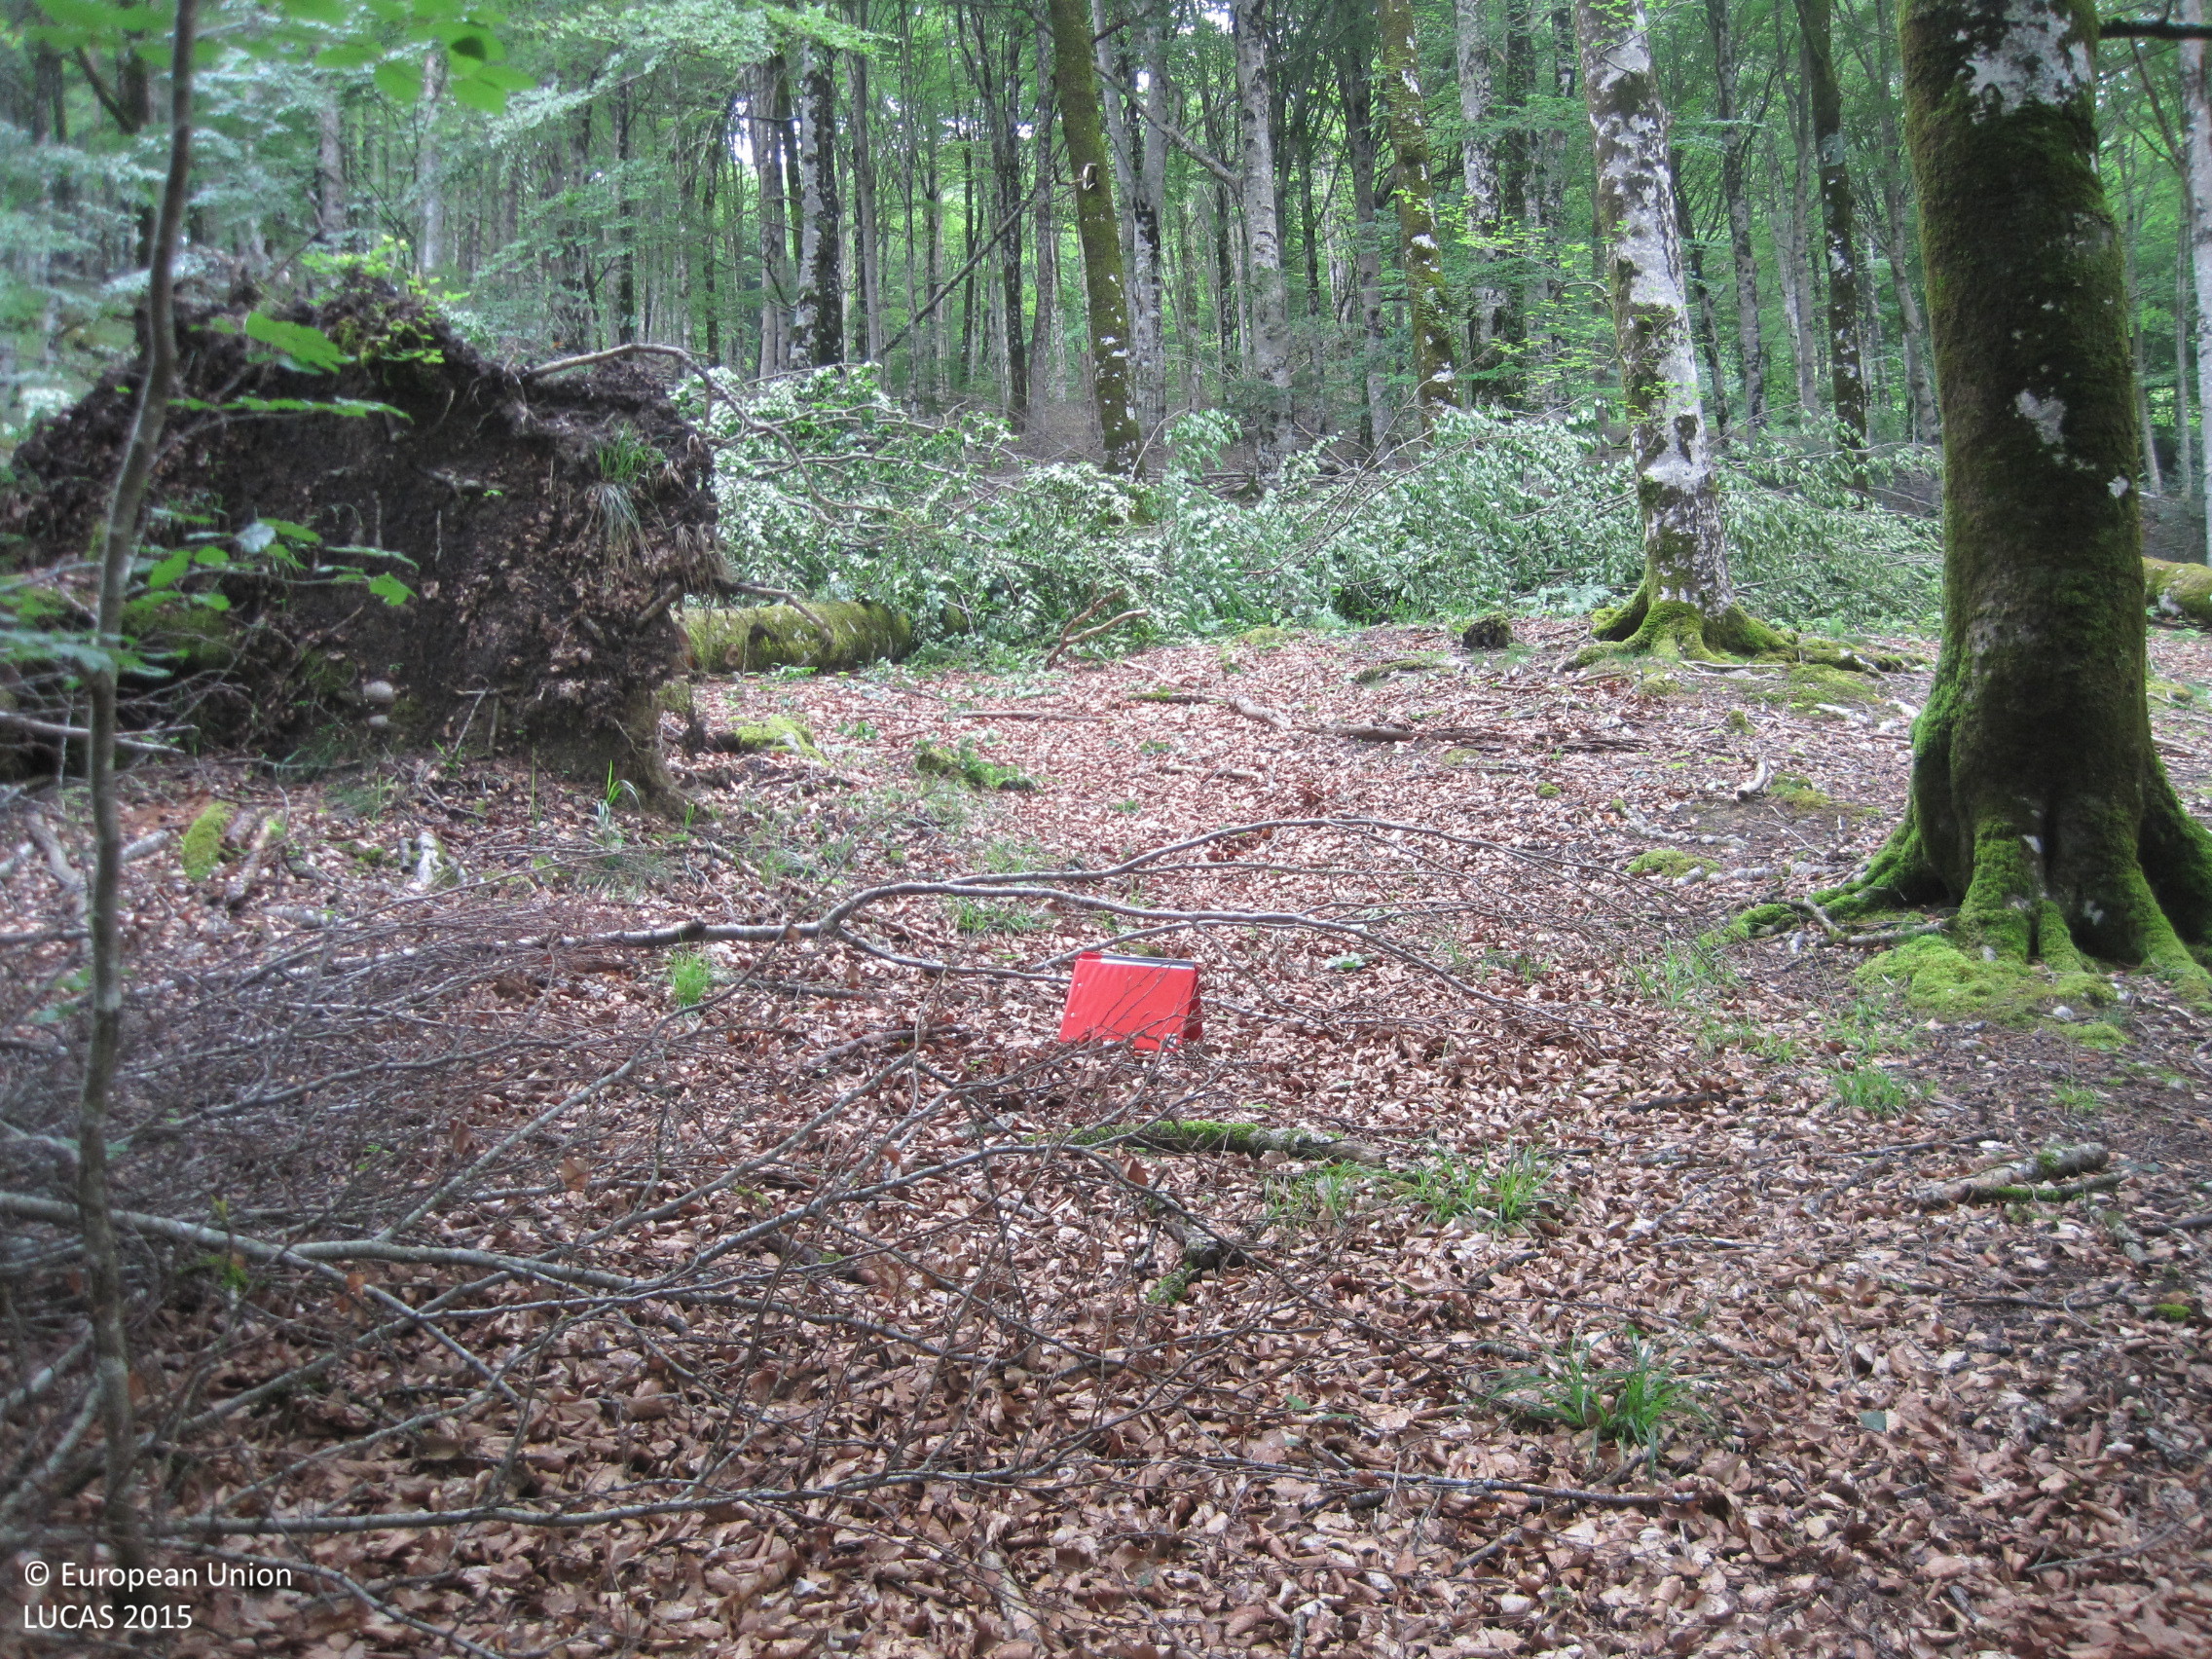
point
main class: Woodland
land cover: Broadleaved woodland
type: beech forest
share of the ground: > 75 %
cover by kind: broadleaved forest trees 100 %
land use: Forestry
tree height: > 5 m
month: June
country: ES
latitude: 42.9333
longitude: -2.2142
